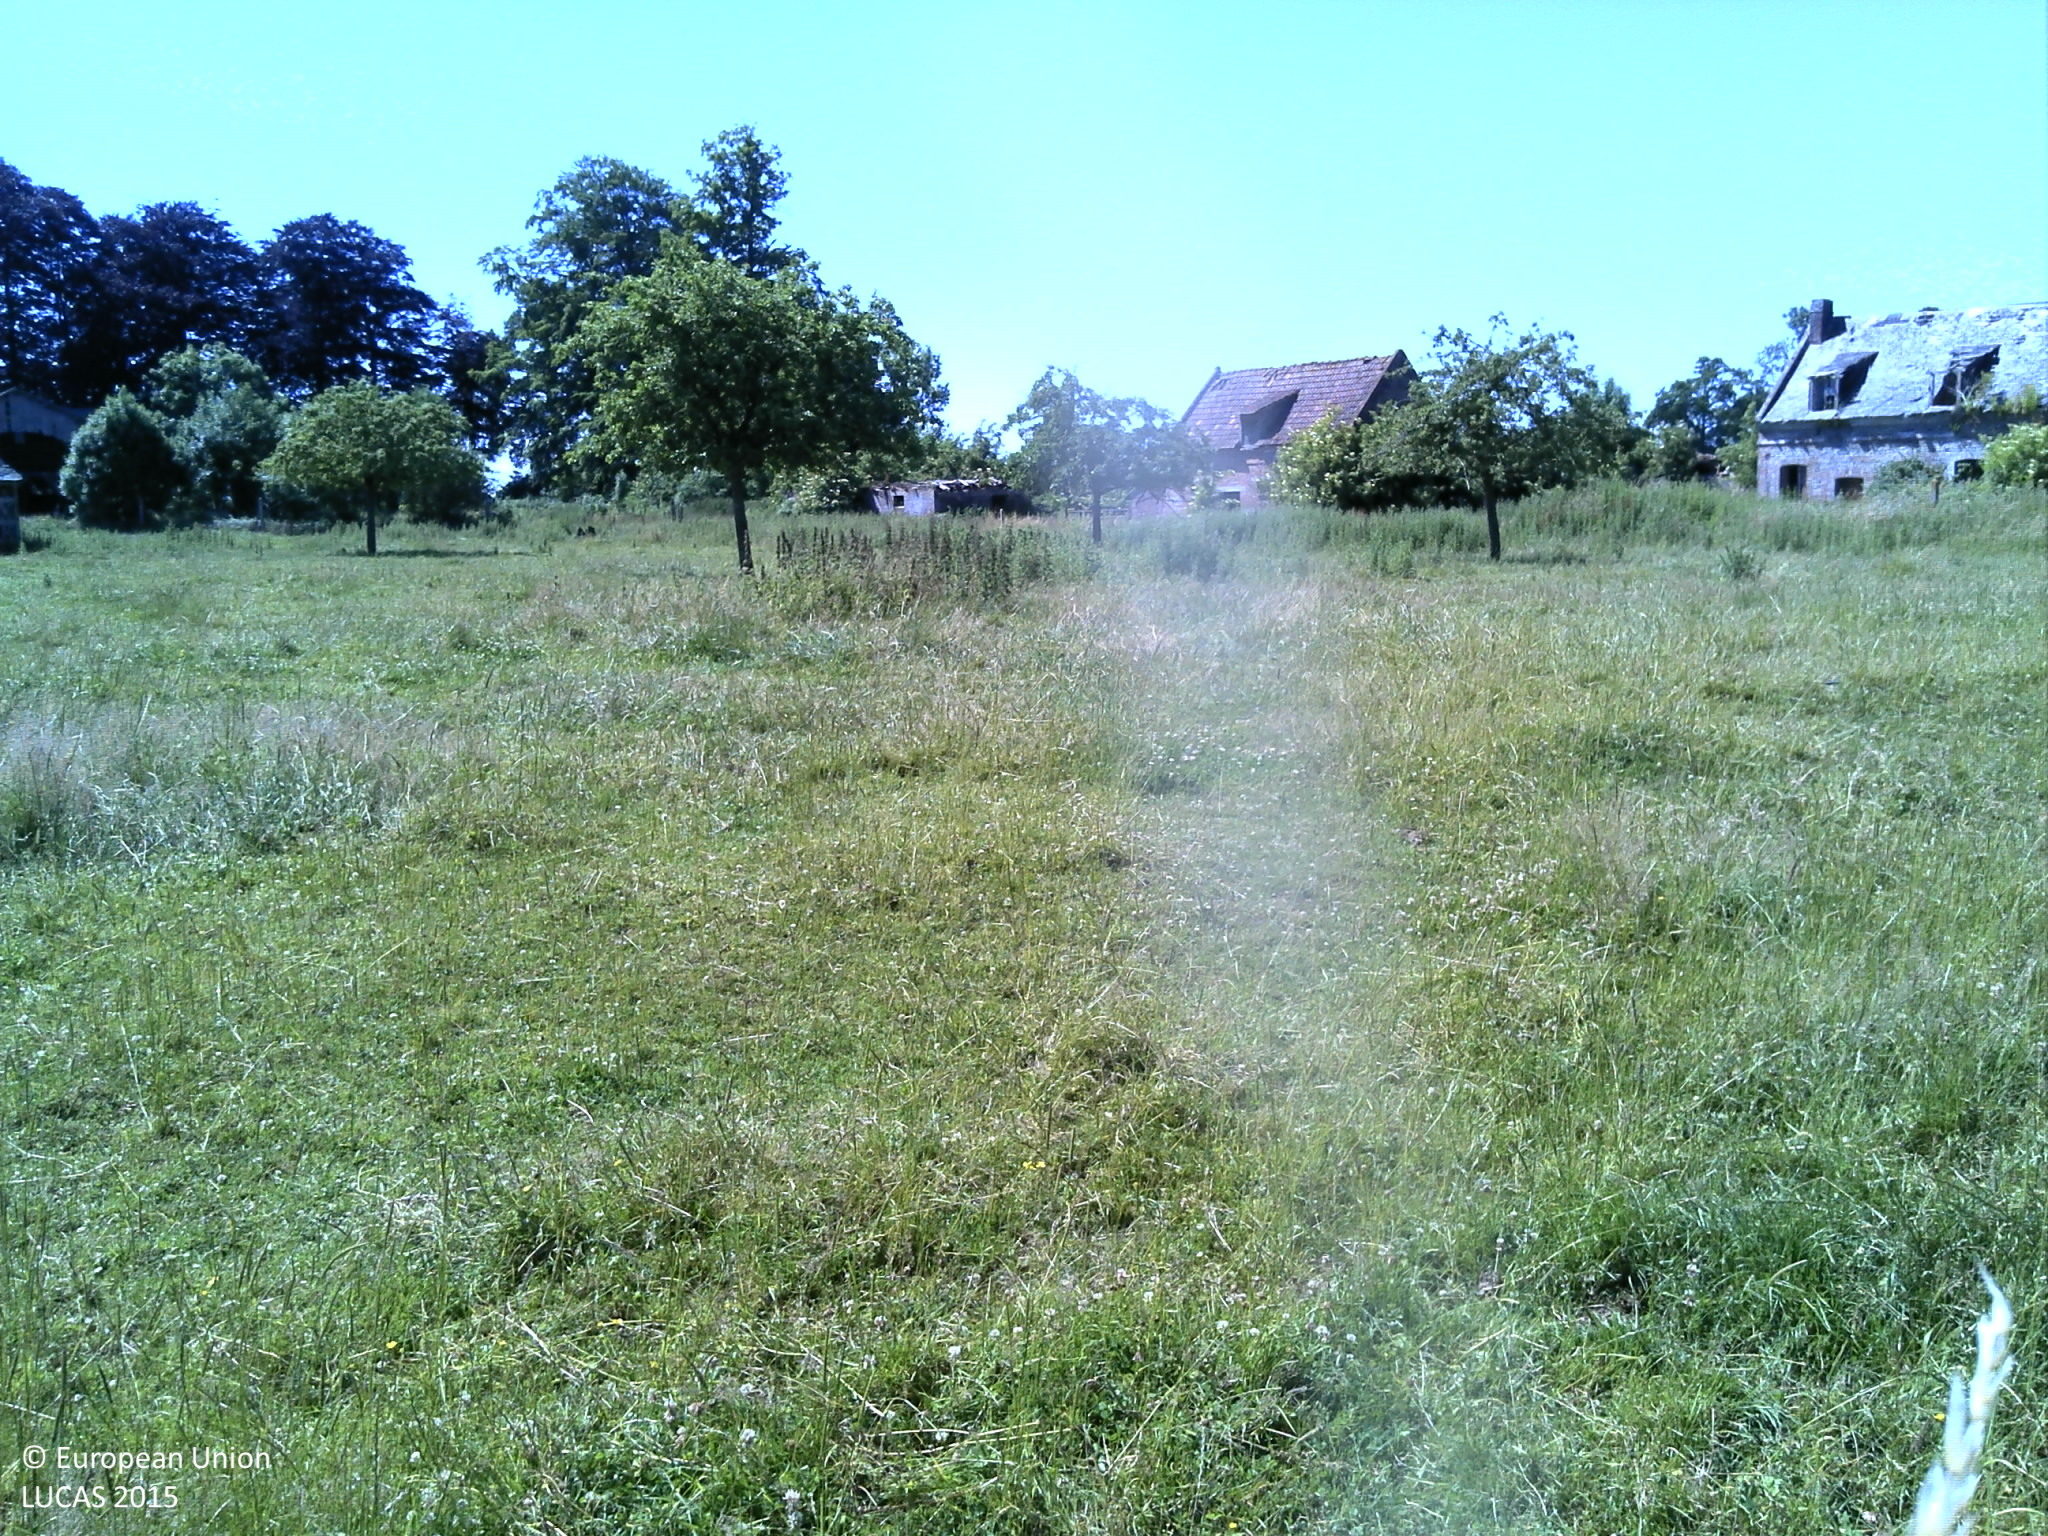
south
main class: Grassland
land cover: Grassland with sparse tree/shrub cover
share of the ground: > 75 %
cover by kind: herbaceous plants 95 %, broadleaved forest trees 5 %
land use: Agriculture (excluding fallow land and kitchen gardens)
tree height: < 5 m
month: June
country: FR
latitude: 49.8308
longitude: 1.0385
